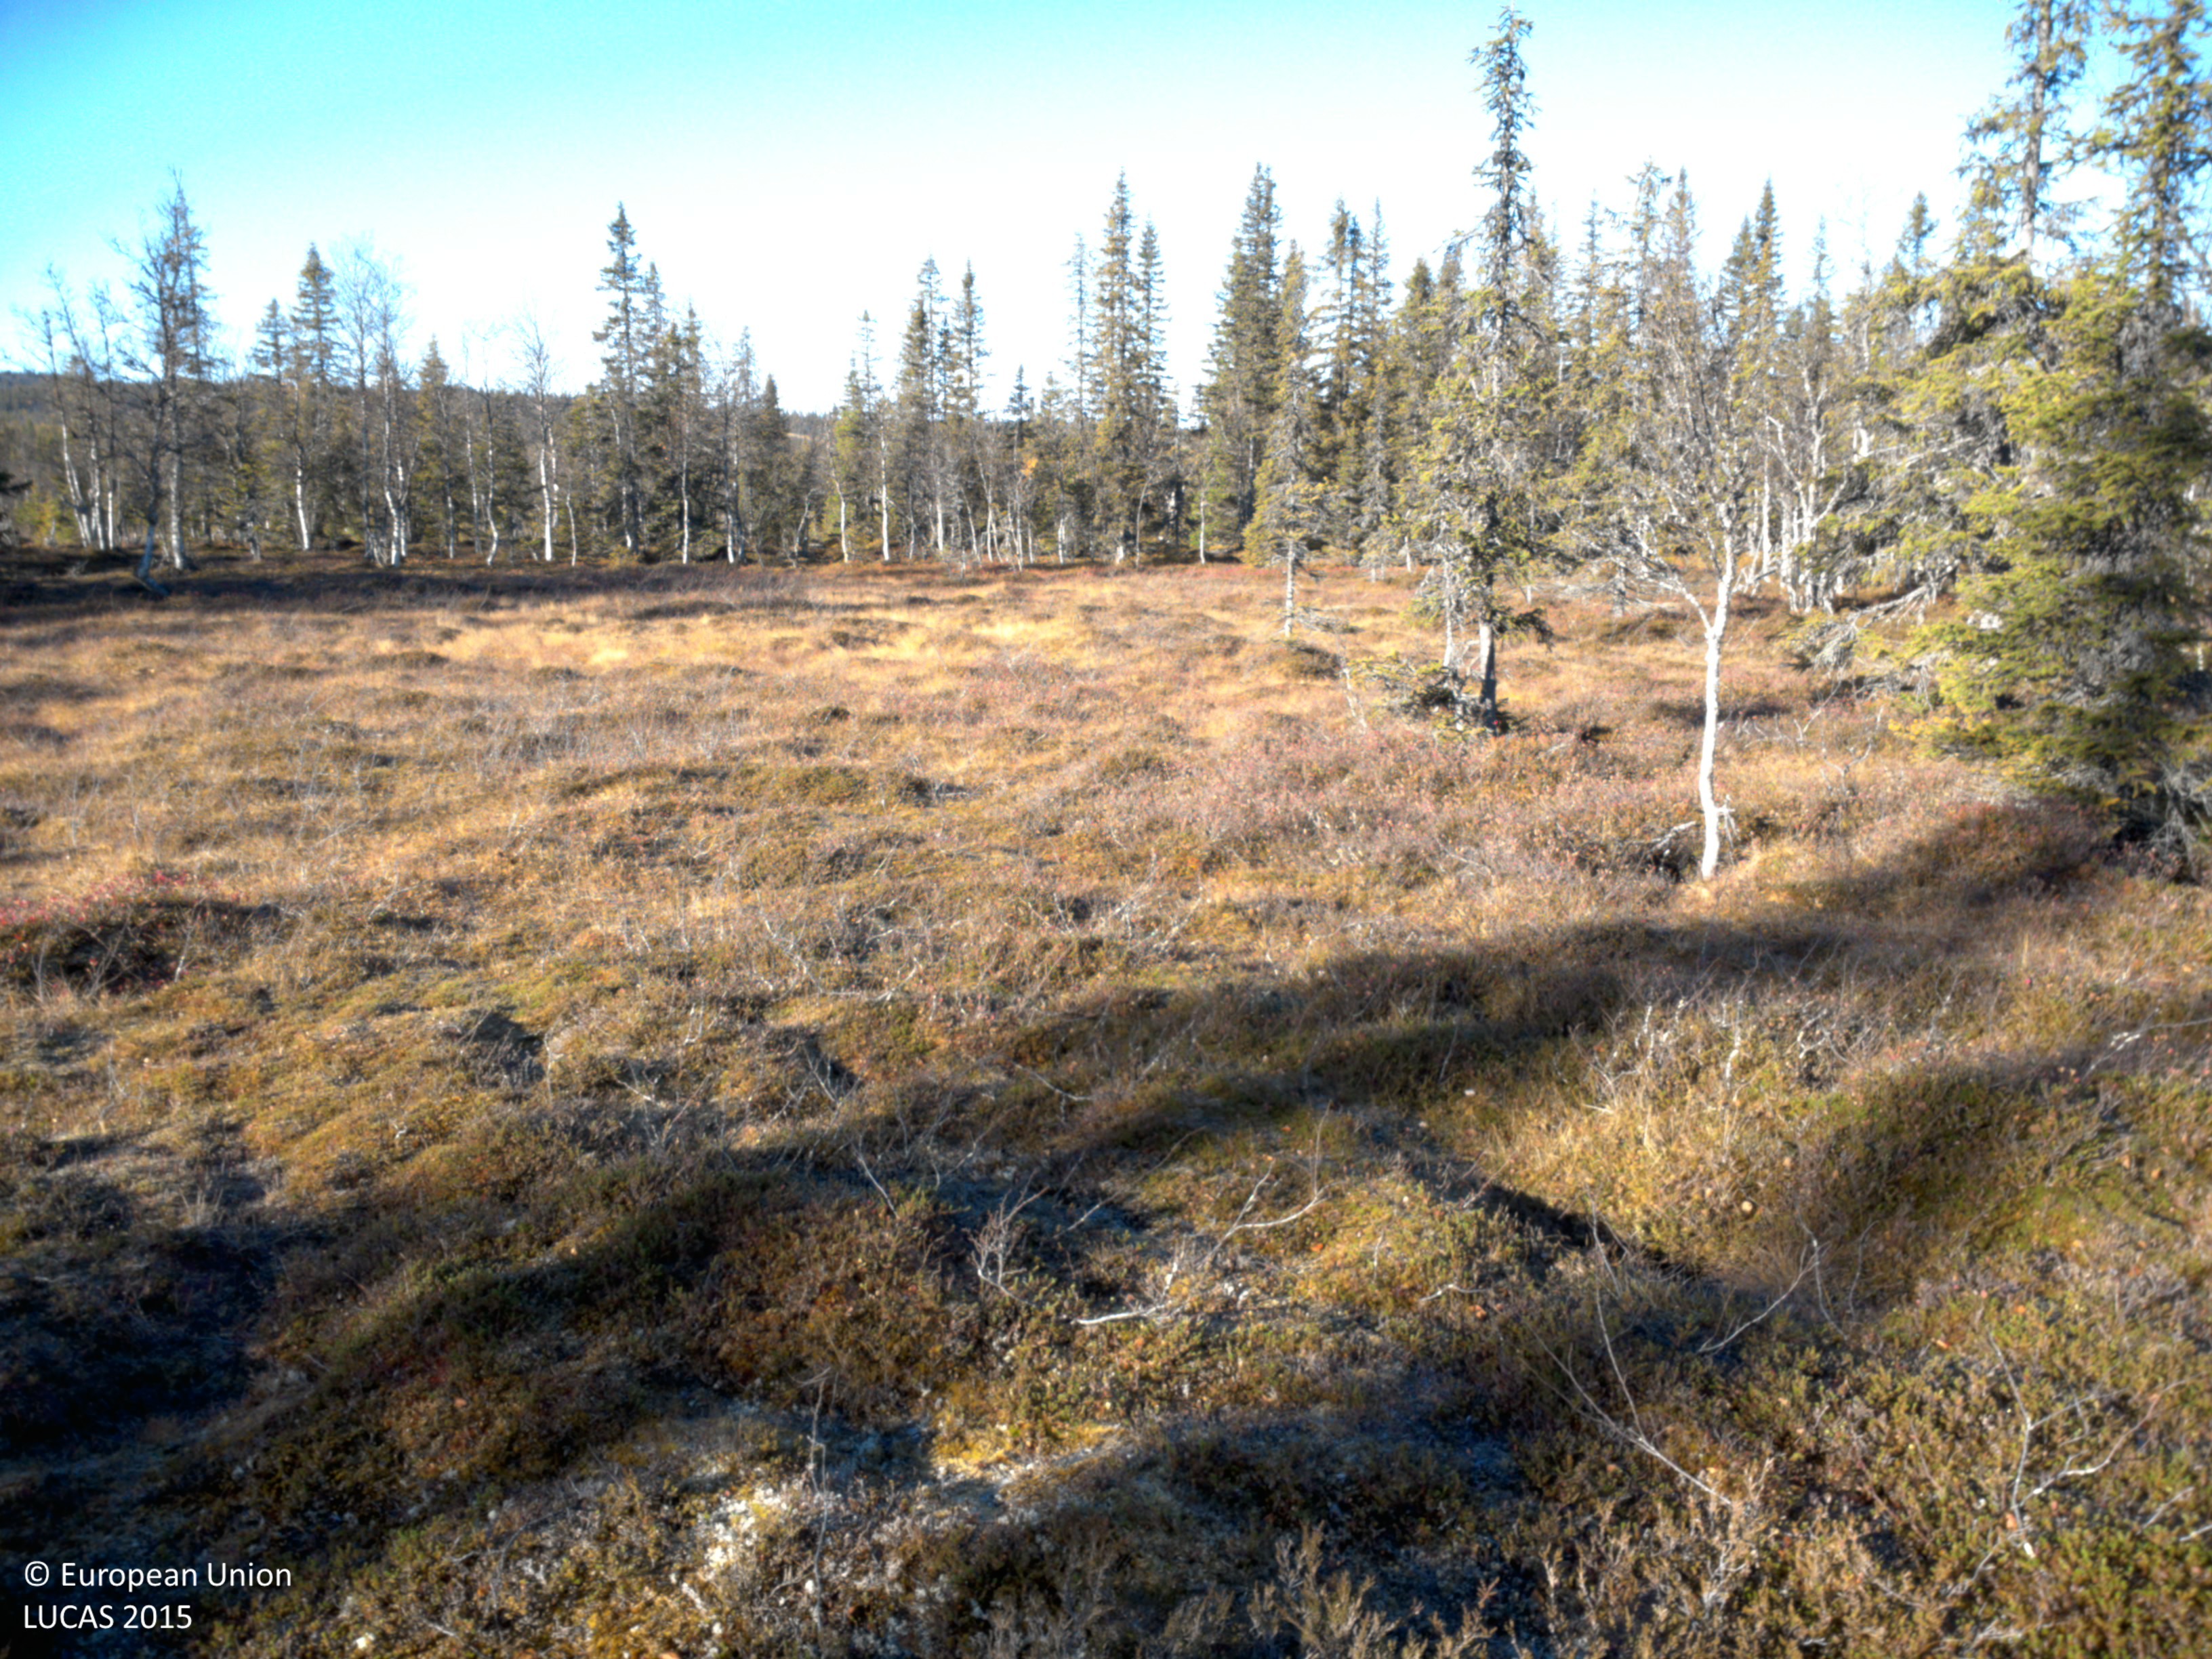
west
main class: Woodland
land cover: Spruce dominated mixed woodland
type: boreal forest
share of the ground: 25 - 50 %
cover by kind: shrubs 35 %, herbaceous plants 30 %, coniferous forest trees 15 %, broadleaved forest trees 15 %, lichens and mosses 5 %
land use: Forestry
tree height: < 5 m
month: October
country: SE
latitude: 64.5917
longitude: 17.7162
